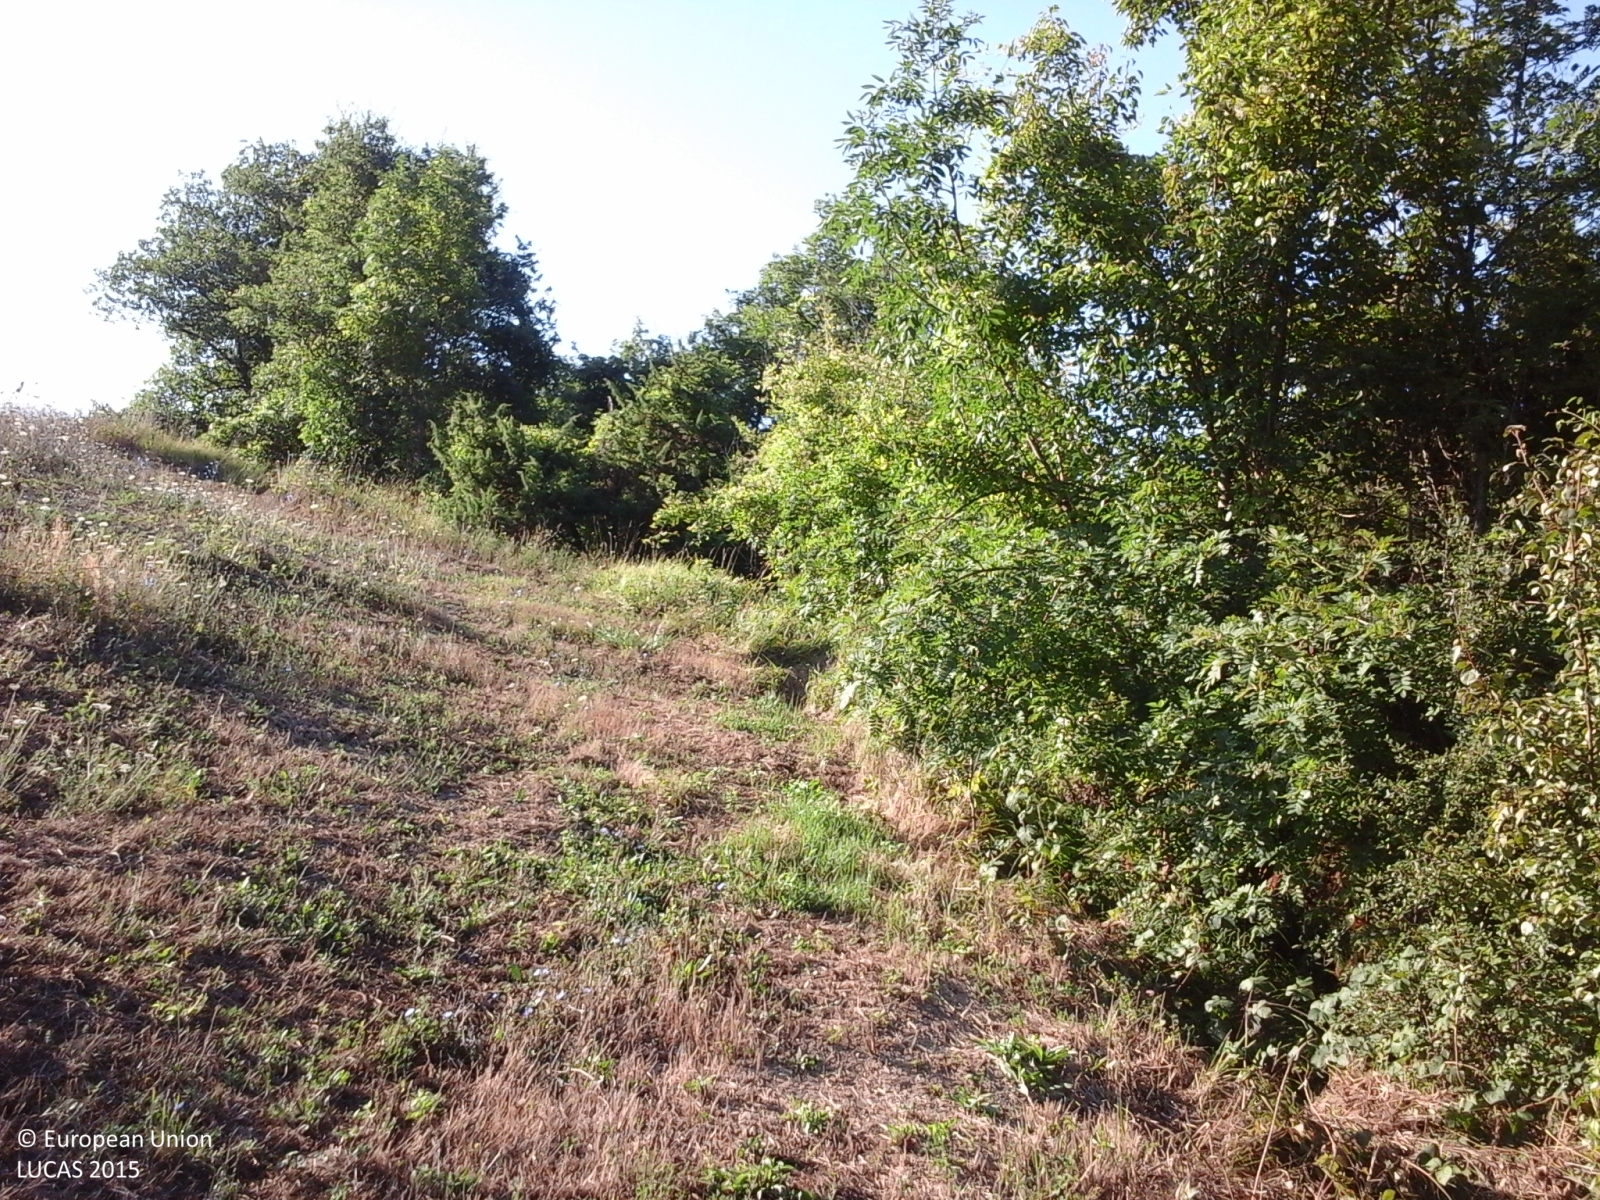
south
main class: Woodland
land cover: Broadleaved woodland
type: thermophilous deciduous forest
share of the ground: > 75 %
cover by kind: broadleaved forest trees 100 %
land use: Semi-natural and natural areas not in use
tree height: > 5 m
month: August
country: IT
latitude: 43.4924
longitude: 12.4050
